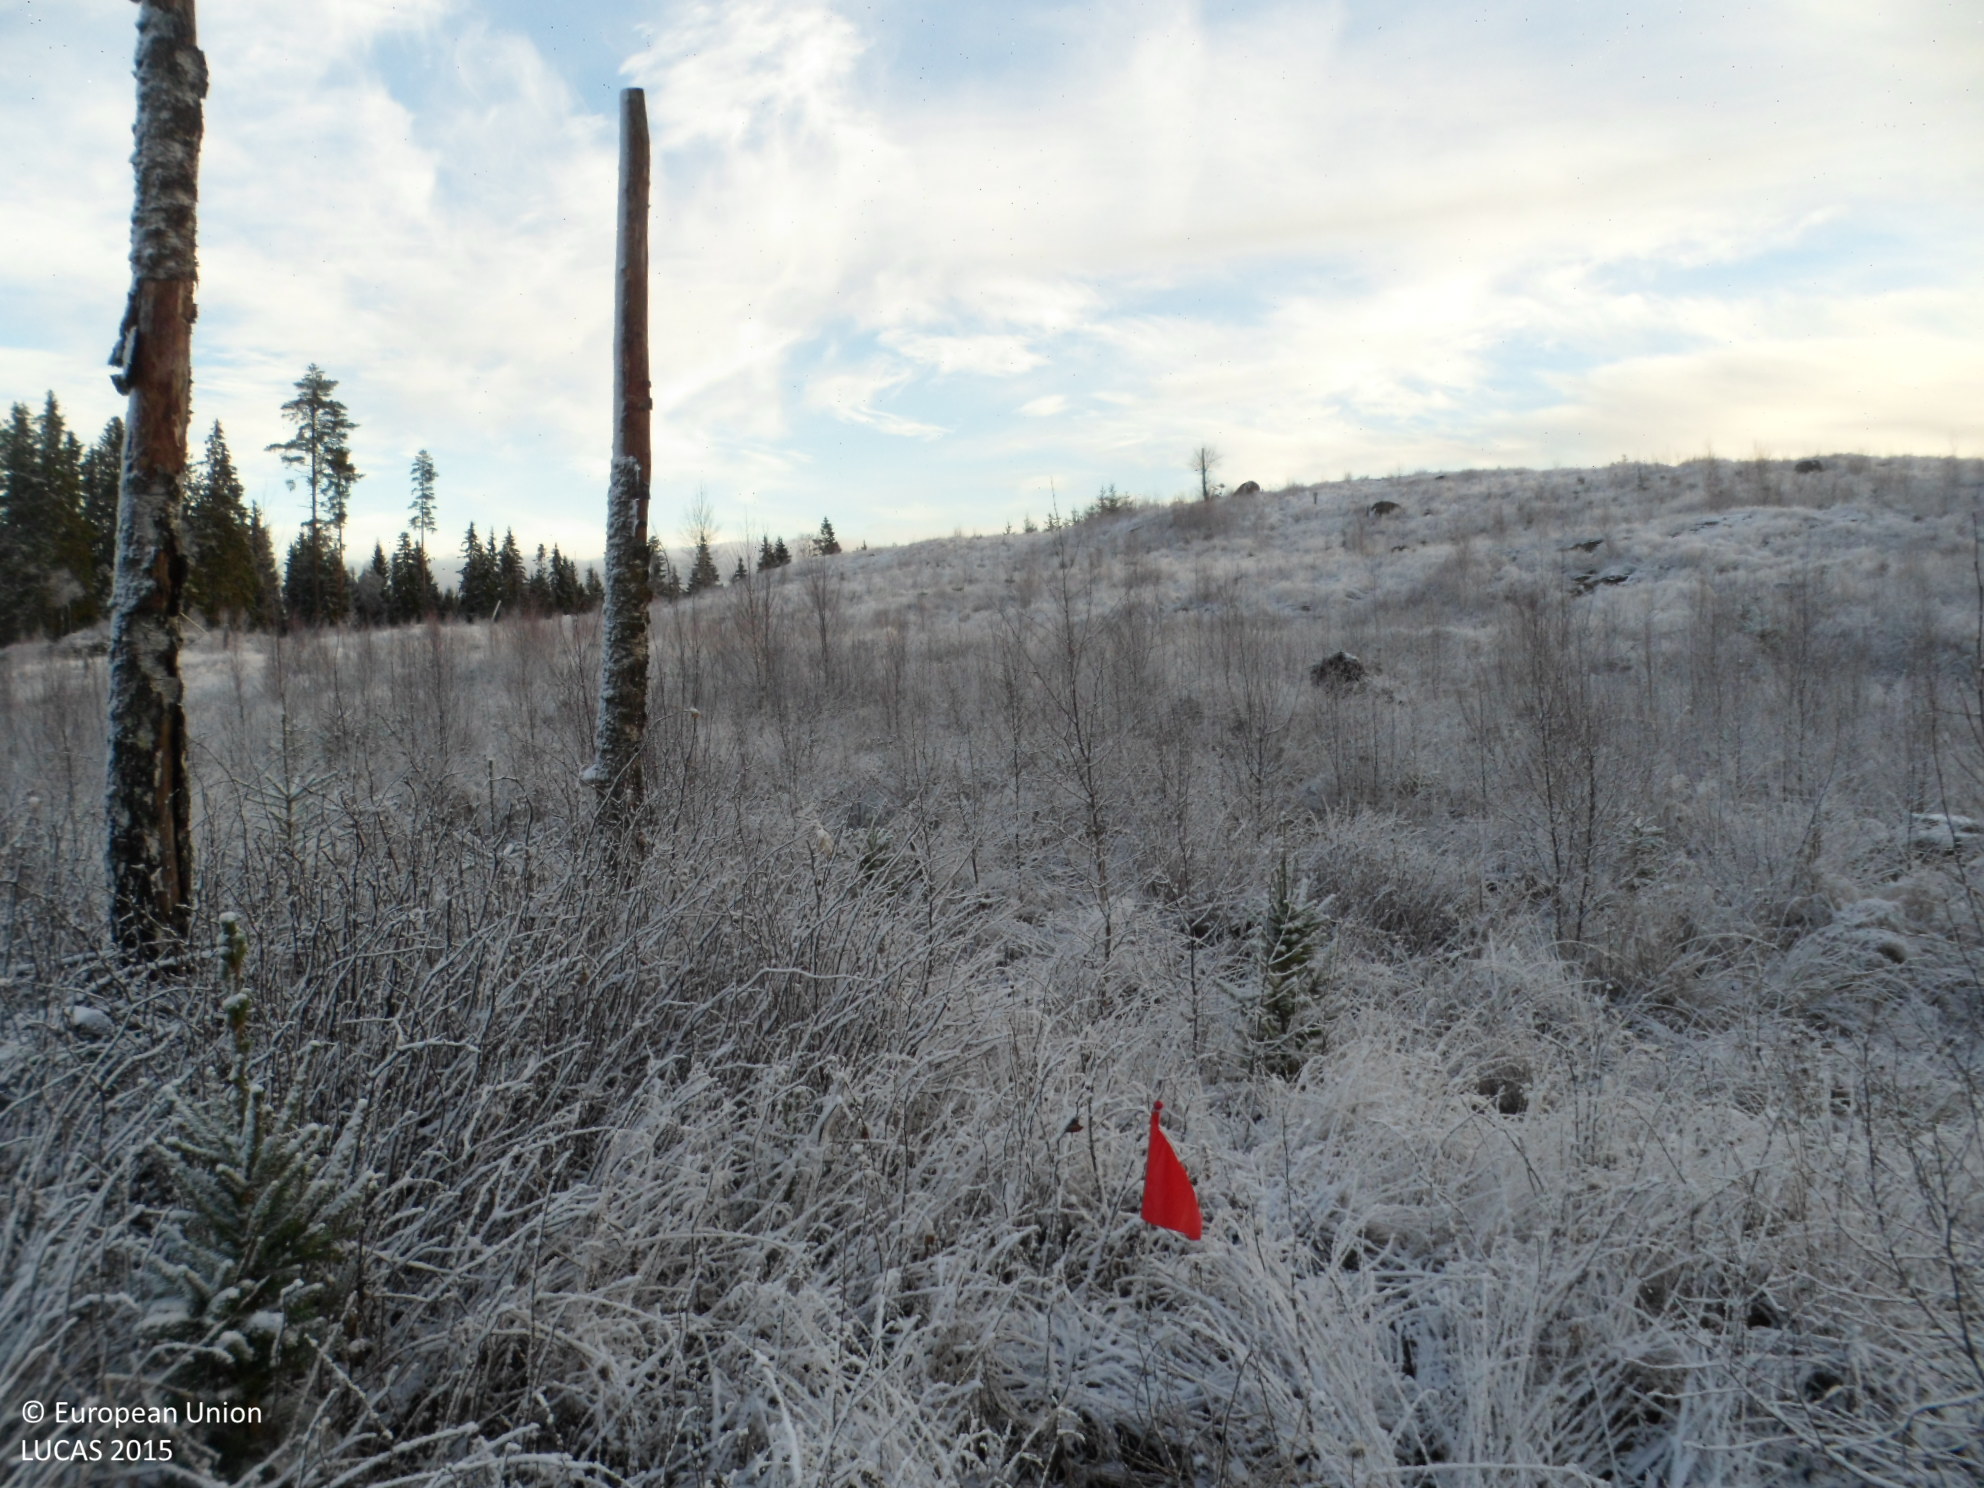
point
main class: Woodland
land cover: Spruce dominated mixed woodland
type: boreal forest
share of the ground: 10 - 25 %
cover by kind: herbaceous plants 60 %, shrubs 20 %, broadleaved forest trees 10 %, coniferous forest trees 5 %, lichens and mosses 5 %
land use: Forestry
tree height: < 5 m
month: November
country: SE
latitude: 57.8236
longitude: 14.3893
